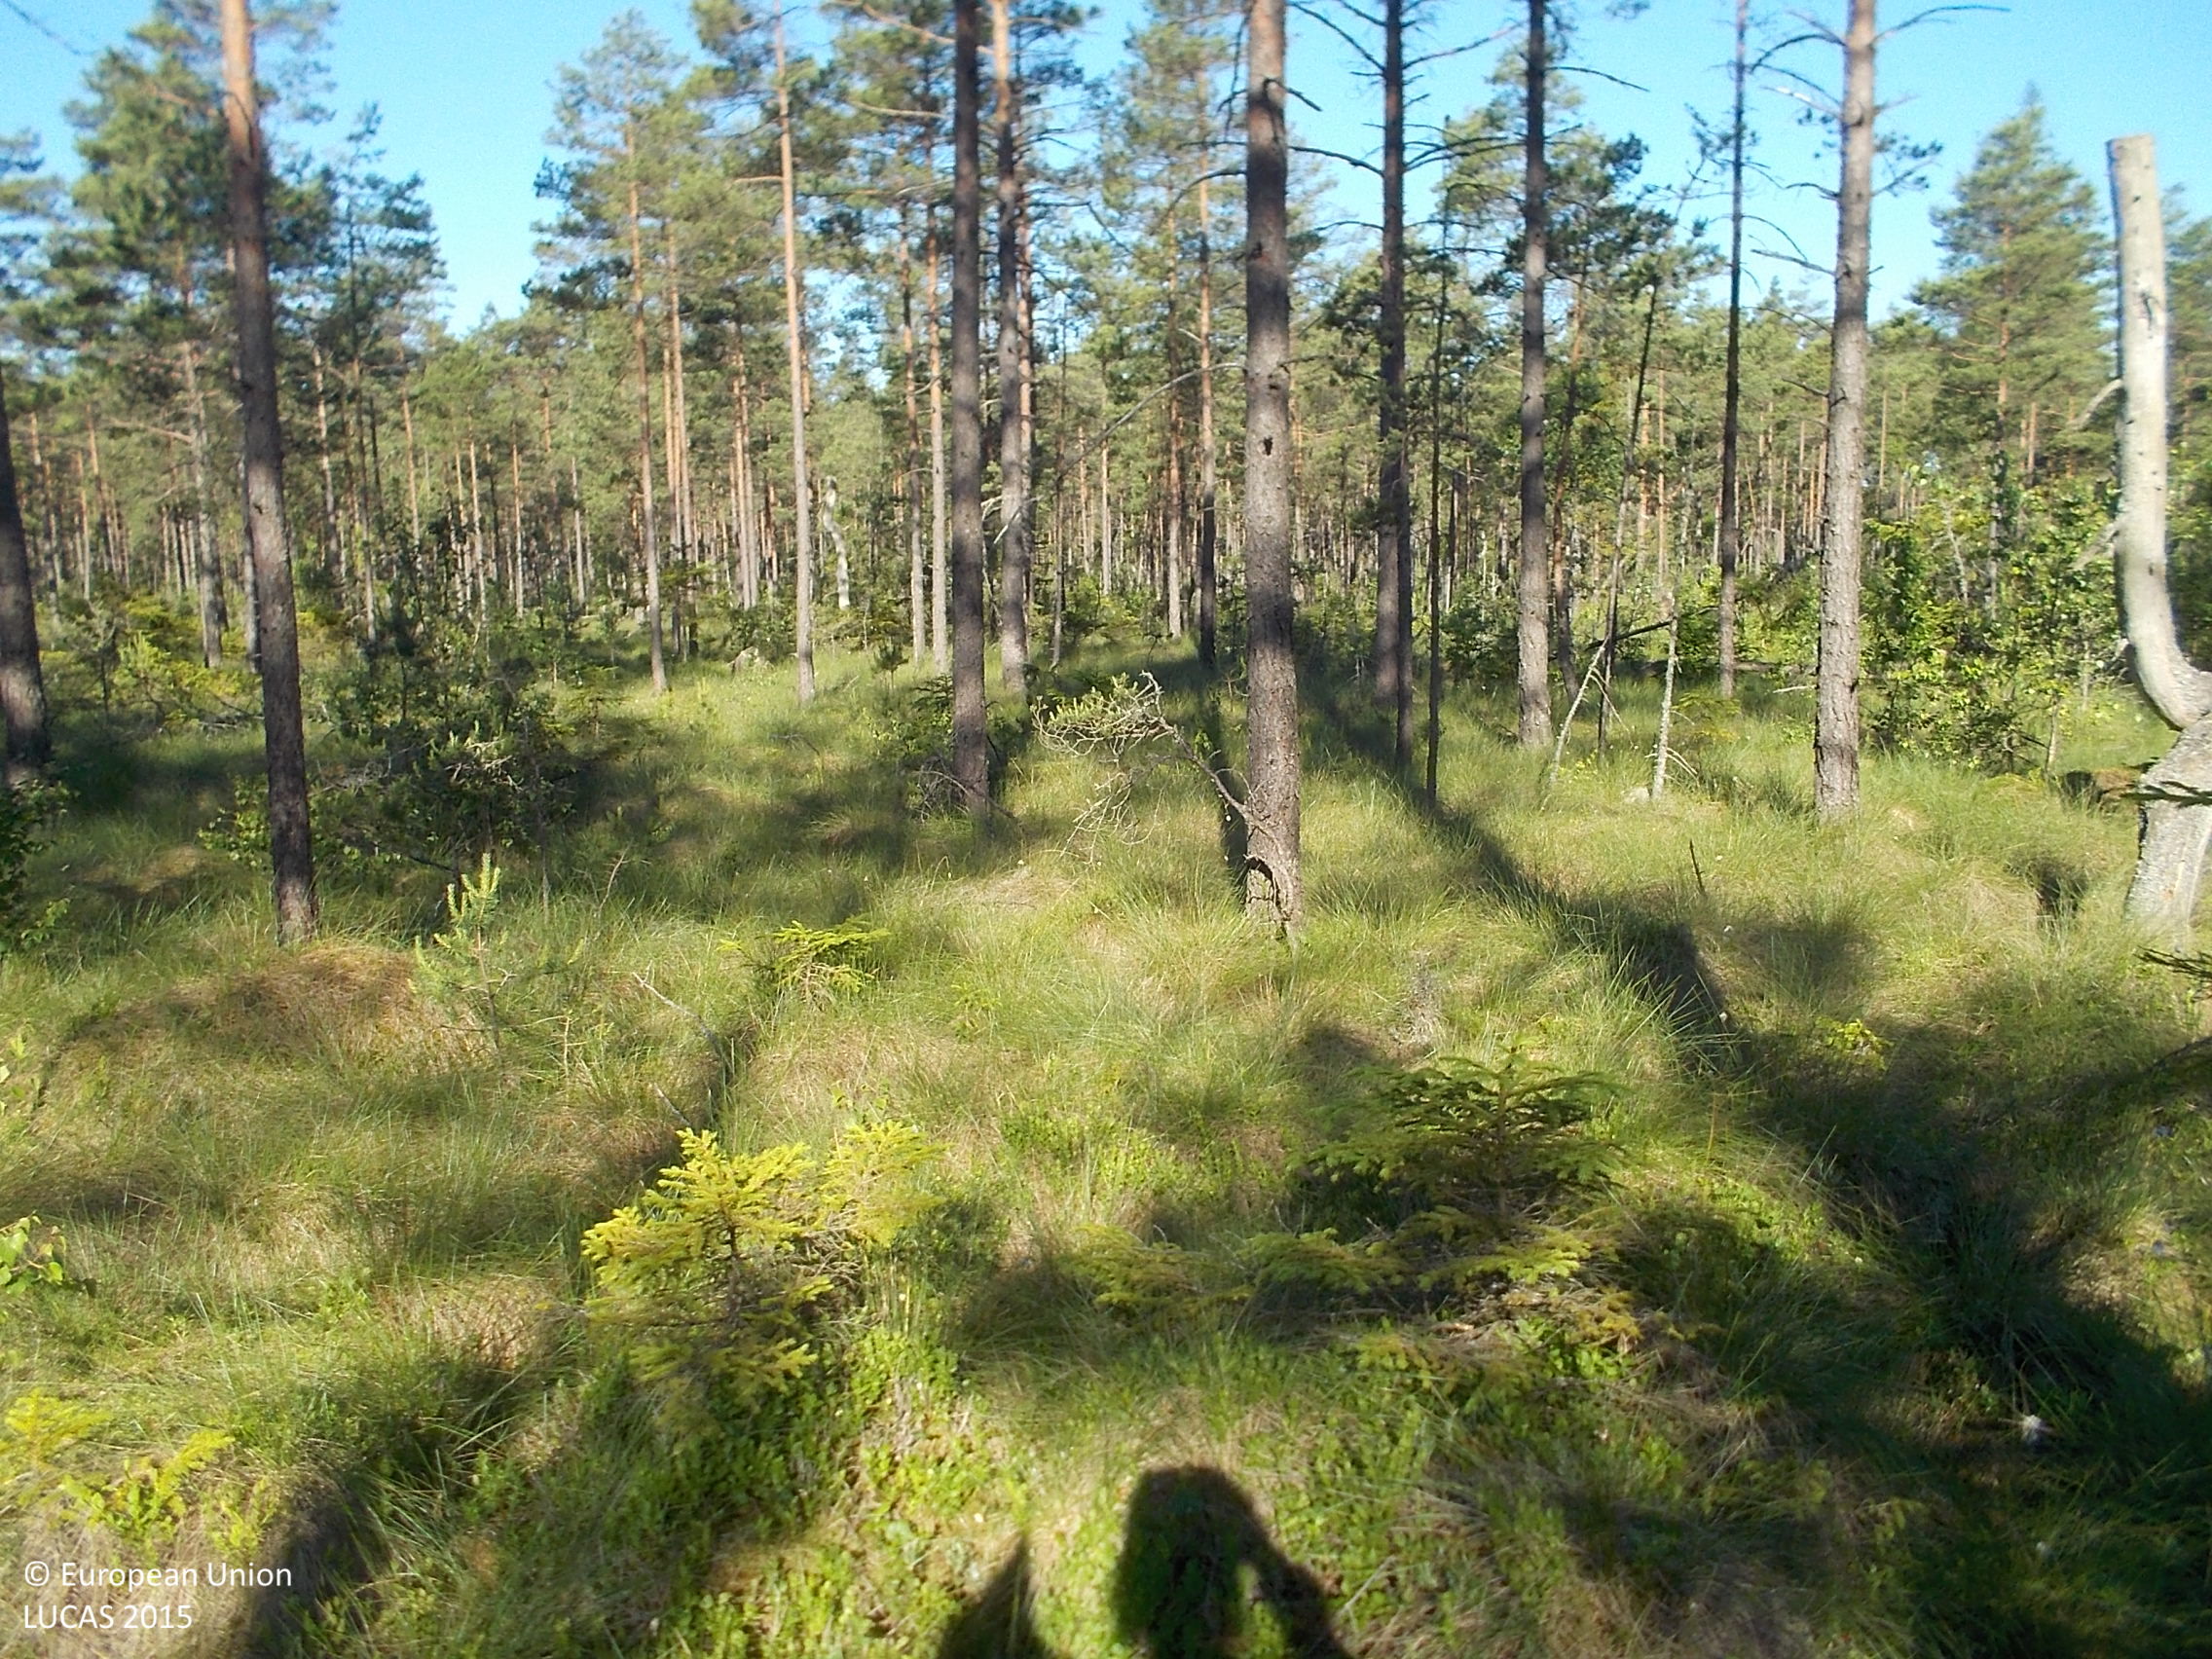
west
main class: Woodland
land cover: Pine dominated coniferous woodland
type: boreal forest
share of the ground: 50 - 75 %
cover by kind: coniferous forest trees 60 %, herbaceous plants 35 %, lichens and mosses 5 %
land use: Forestry
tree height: > 5 m
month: July
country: SE
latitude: 57.2465
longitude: 13.1614
